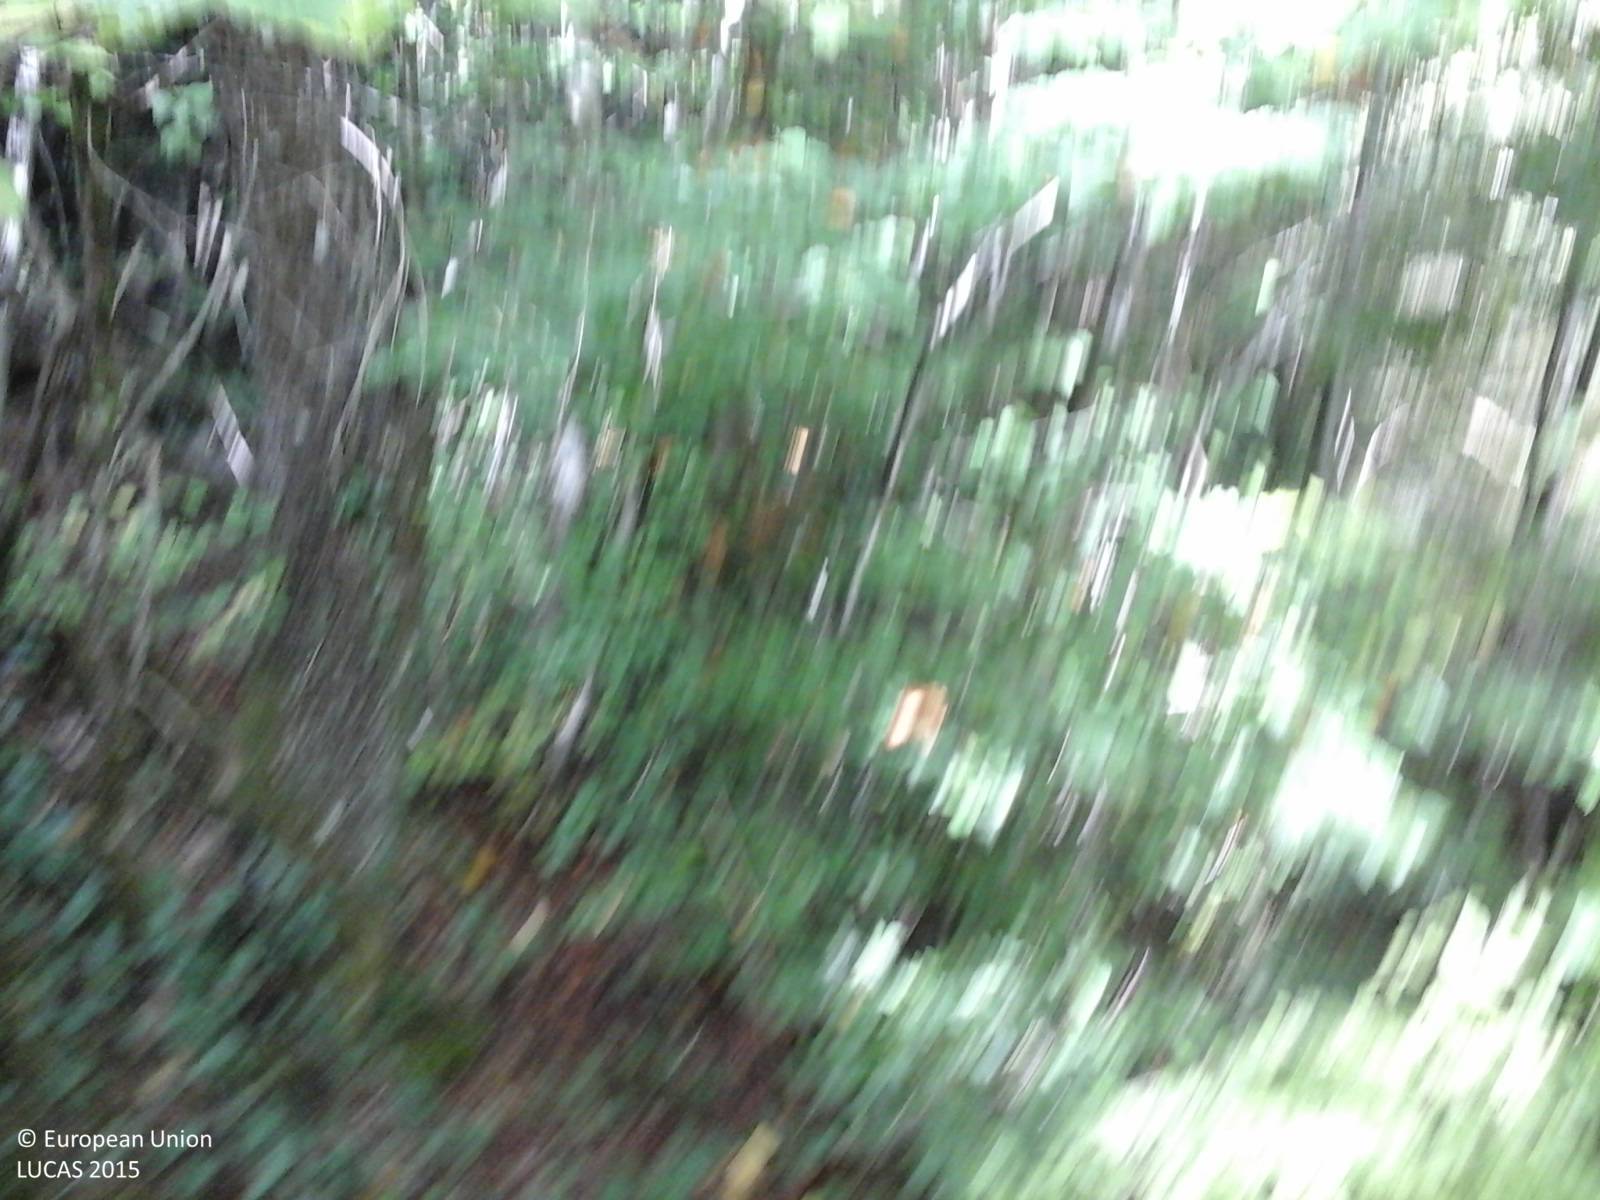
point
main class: Woodland
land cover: Broadleaved woodland
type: thermophilous deciduous forest
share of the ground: > 75 %
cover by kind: broadleaved forest trees 100 %
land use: Forestry
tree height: > 5 m
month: October
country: IT
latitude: 42.5142
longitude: 13.1667
